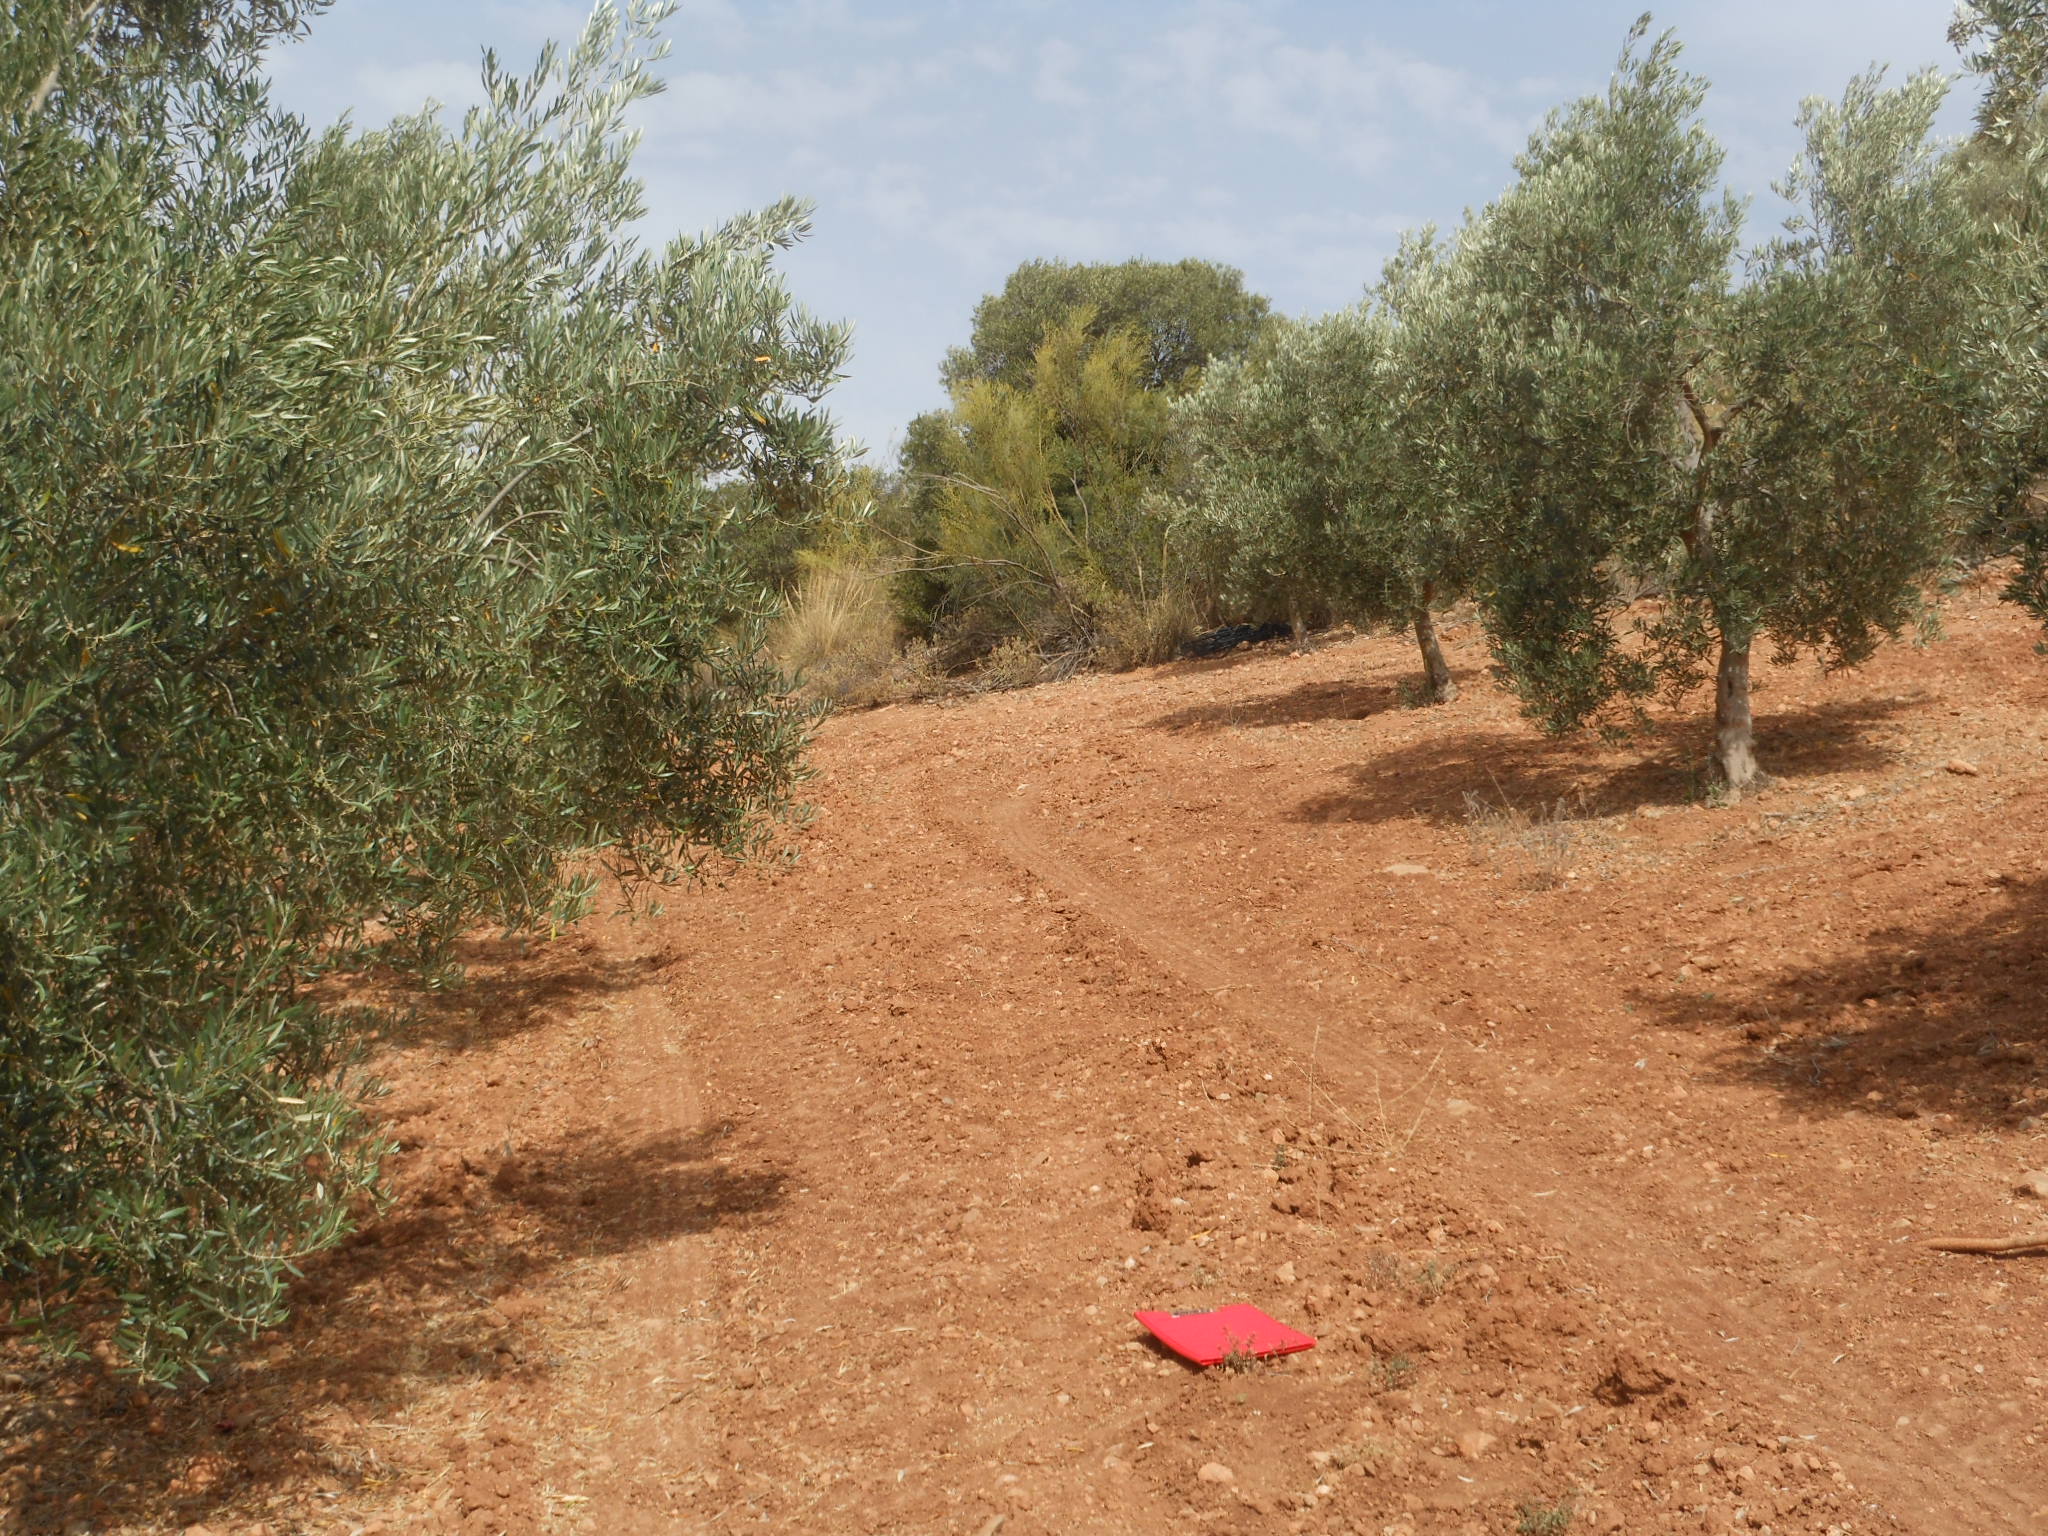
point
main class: Cropland
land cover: Olive groves
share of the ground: 10 - 25 %
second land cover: Other bare soil
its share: > 75 %
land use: Agriculture (excluding fallow land and kitchen gardens)
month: June
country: ES
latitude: 37.1911
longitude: -5.0222
